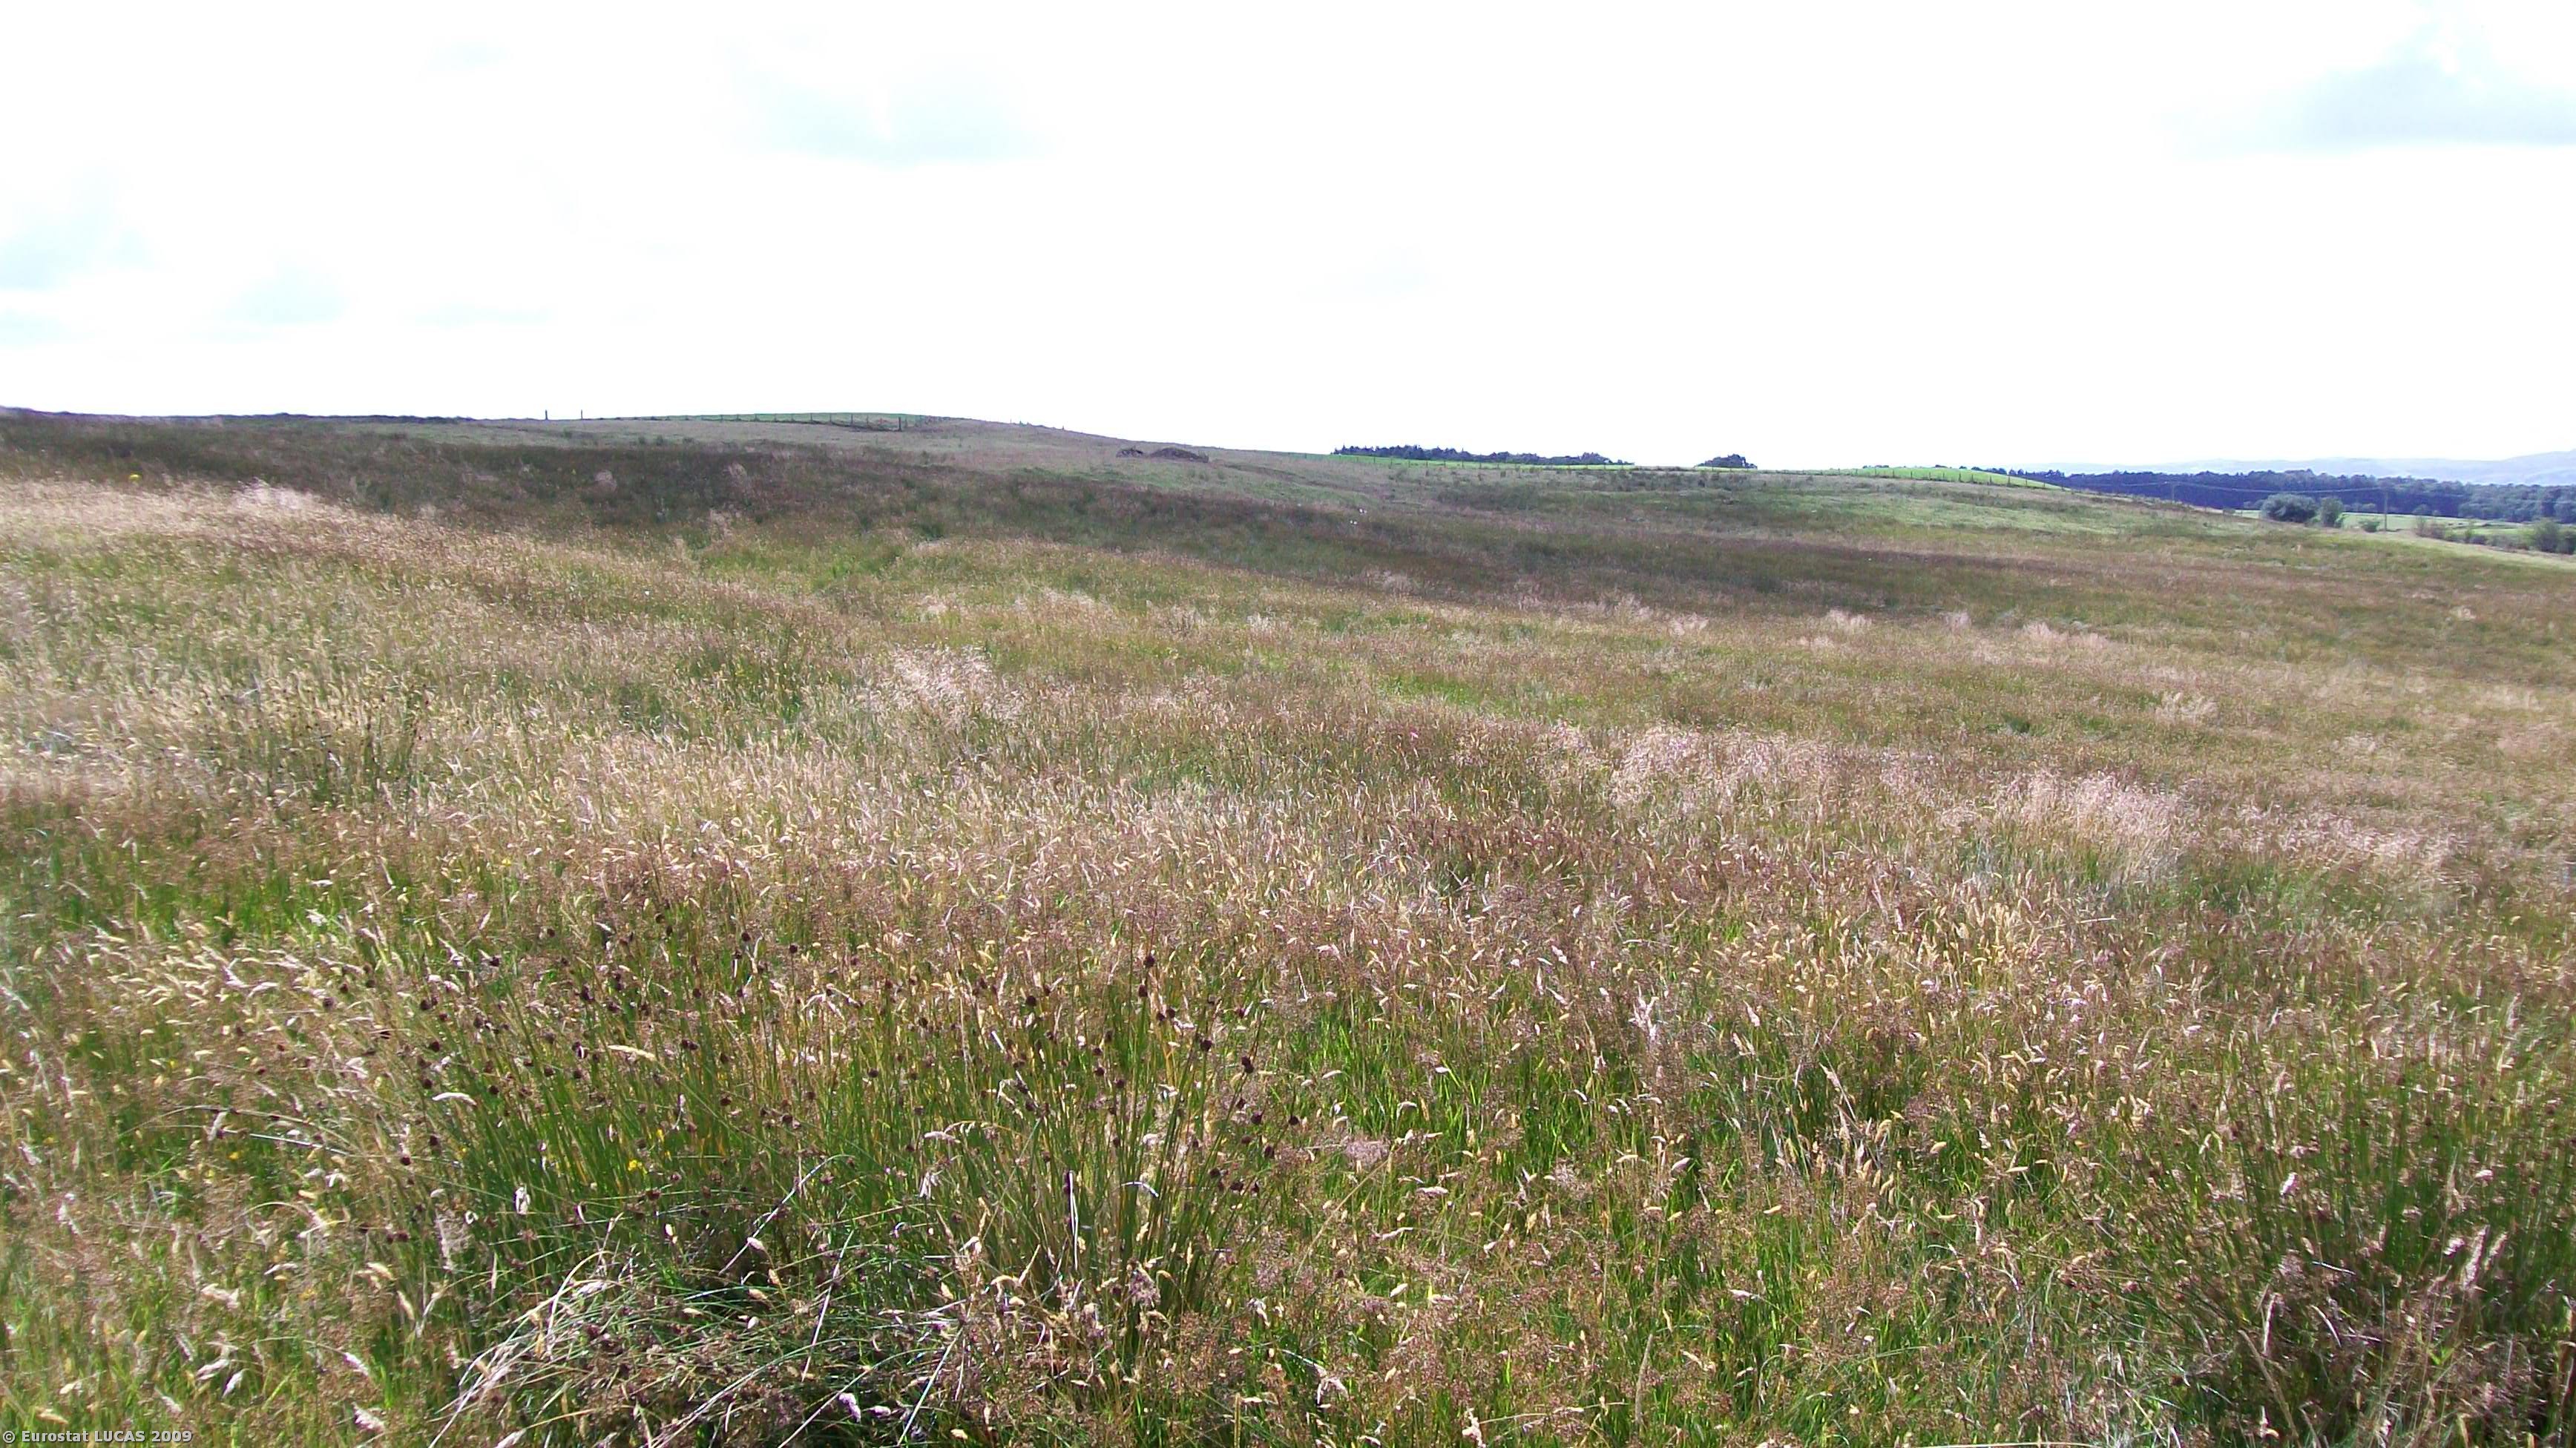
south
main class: Grassland
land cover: Grassland without tree/shrub cover
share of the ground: > 75 %
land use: Agriculture (excluding fallow land and kitchen gardens)
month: August
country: GB
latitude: 55.2082
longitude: -3.3880
